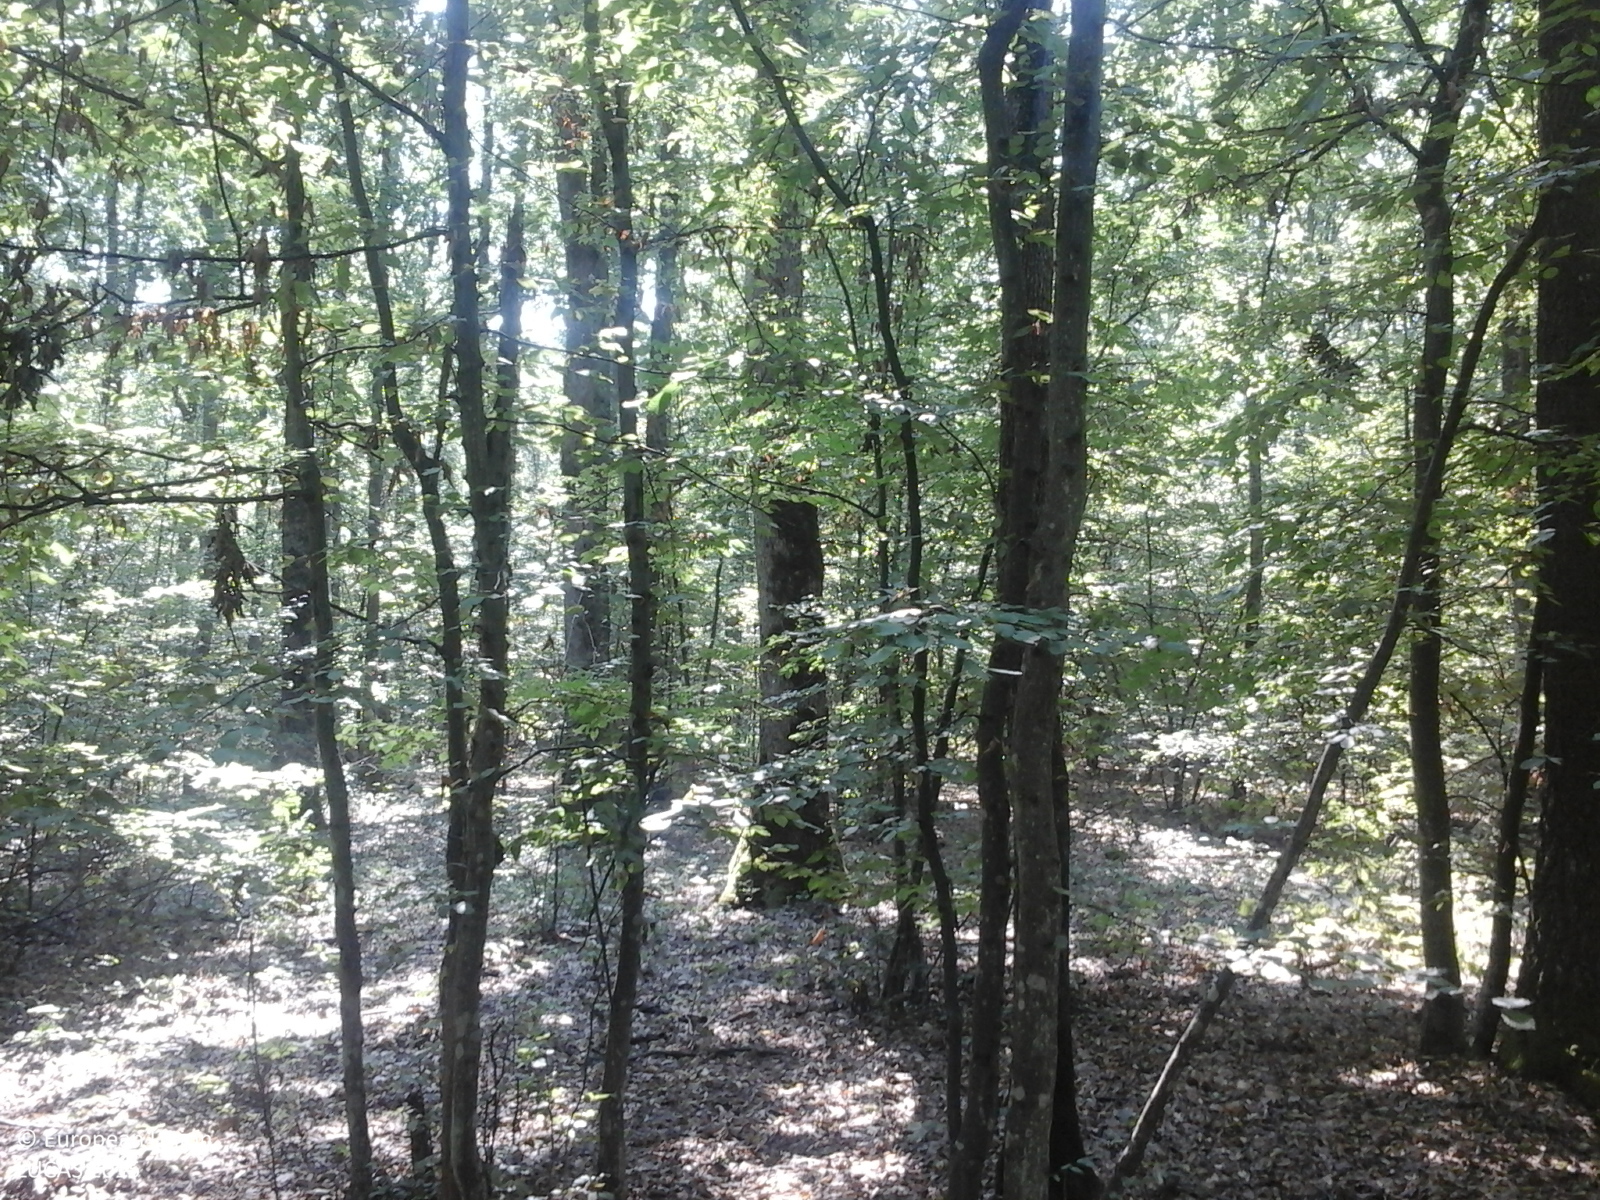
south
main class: Woodland
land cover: Broadleaved woodland
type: beech forest
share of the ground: > 75 %
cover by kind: broadleaved forest trees 100 %
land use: Forestry
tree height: > 5 m
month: August
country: RO
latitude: 46.3715
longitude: 21.9375
